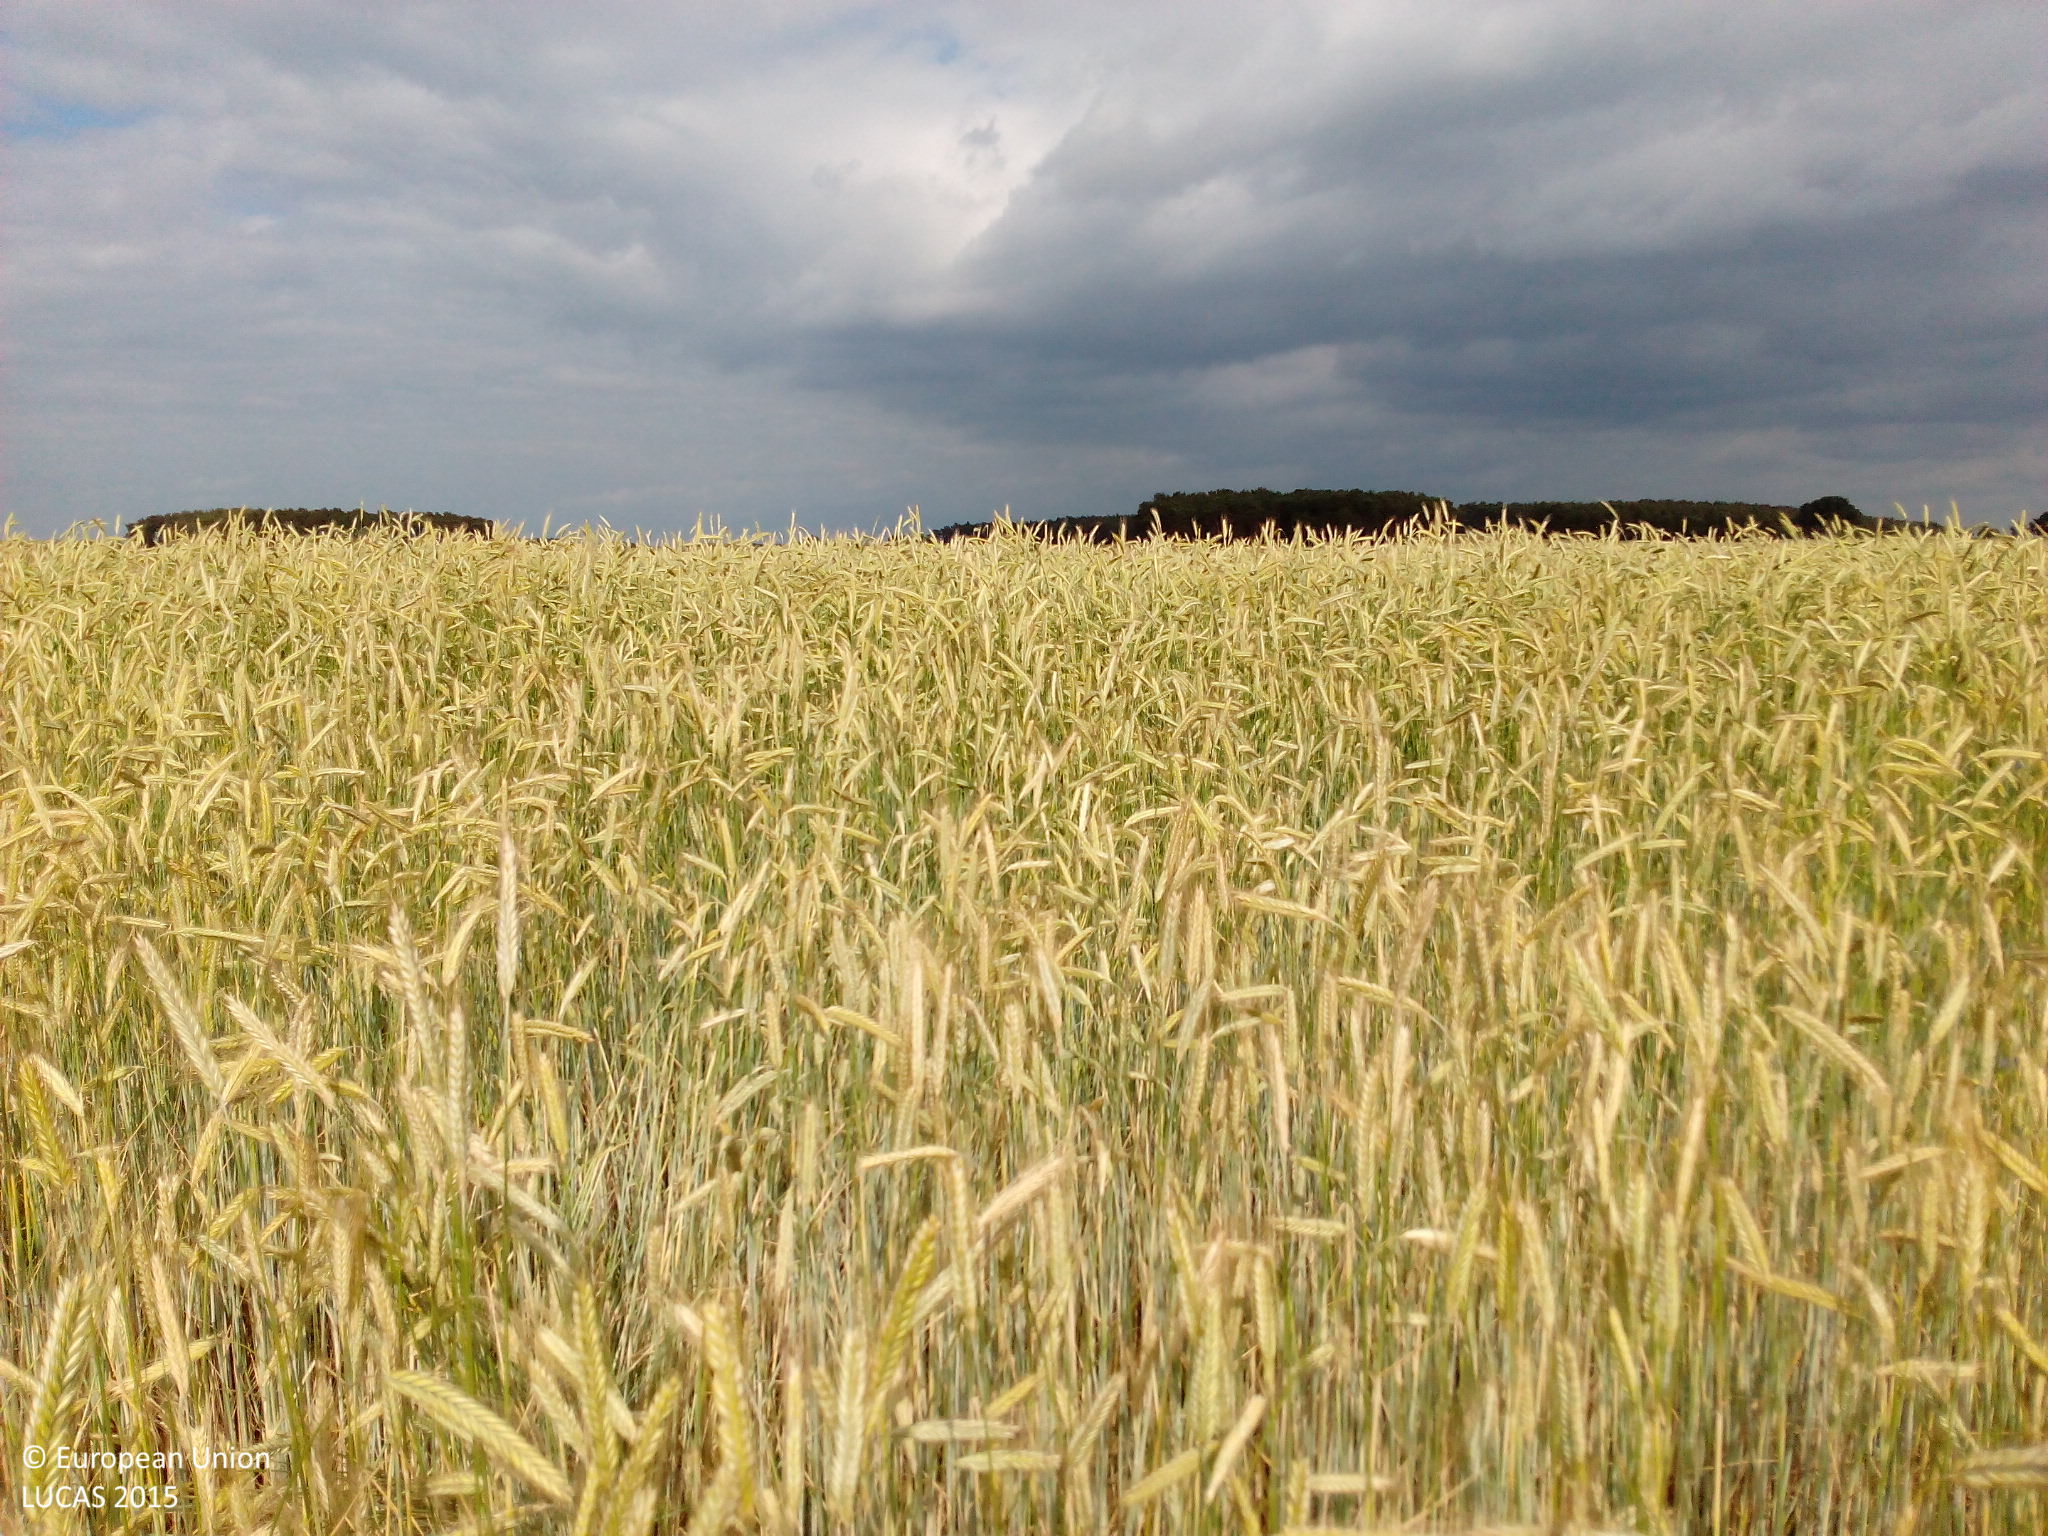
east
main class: Cropland
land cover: Rye
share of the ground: > 75 %
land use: Agriculture (excluding fallow land and kitchen gardens)
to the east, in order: Rye
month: June
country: DE
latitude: 52.2468
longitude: 12.3284
